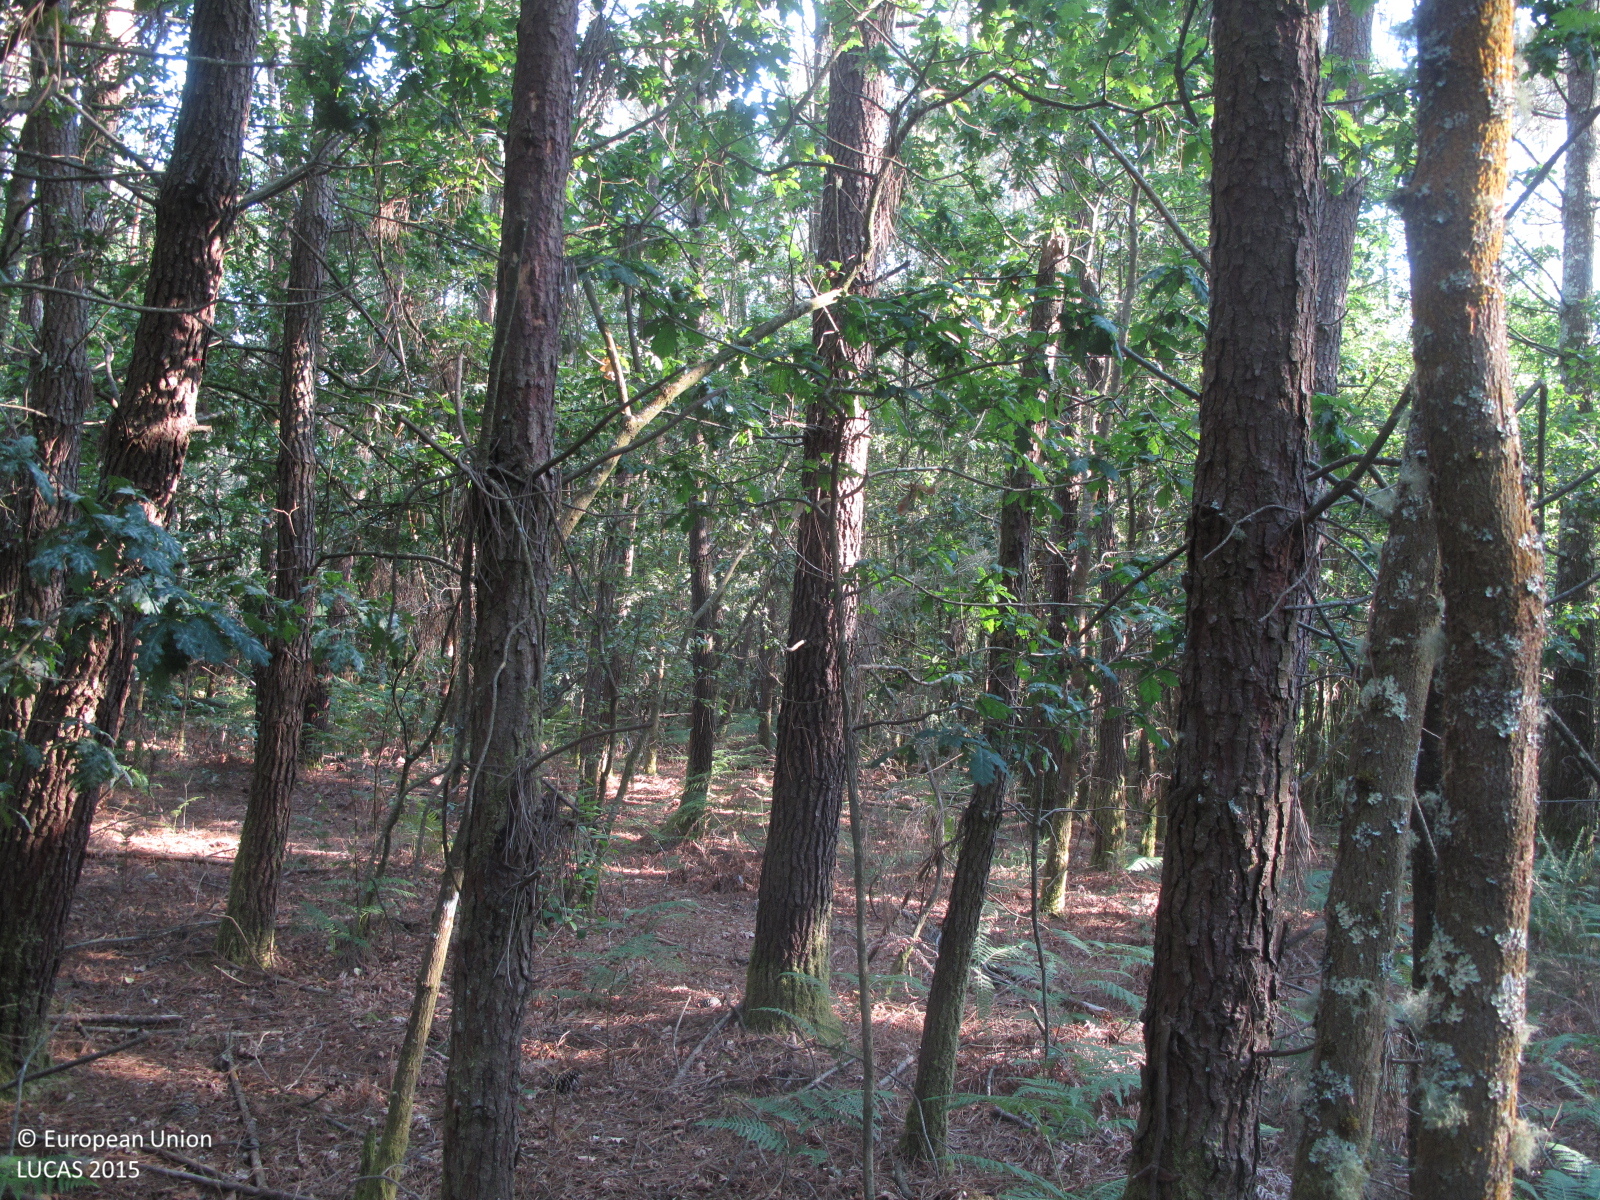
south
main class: Woodland
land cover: Other mixed woodland
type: acidophilous oak and oak-birch forest
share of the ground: > 75 %
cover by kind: broadleaved forest trees 50 %, coniferous forest trees 30 %, shrubs 10 %, unconsolidated bare surface 10 %
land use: Forestry
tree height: > 5 m
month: July
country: ES
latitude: 43.3387
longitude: -8.0678
